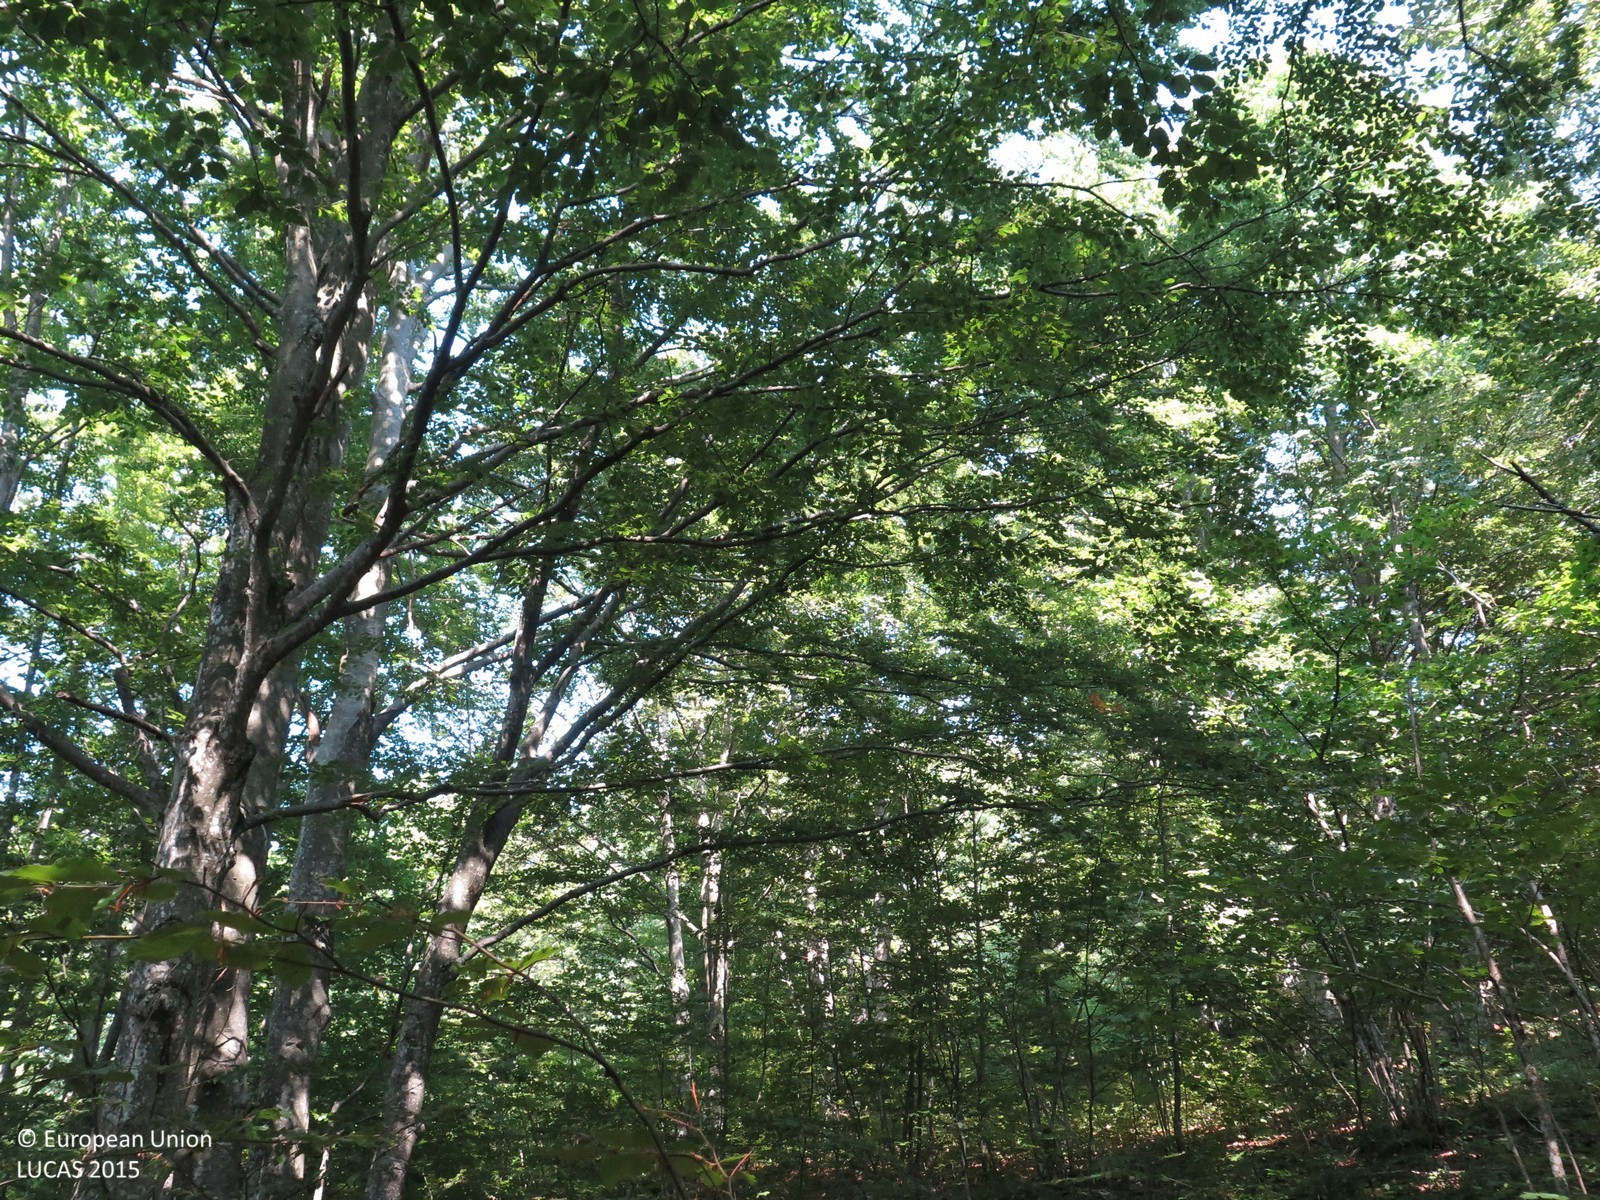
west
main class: Woodland
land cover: Broadleaved woodland
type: beech forest
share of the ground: > 75 %
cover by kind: broadleaved forest trees 95 %, unconsolidated bare surface 5 %
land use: Forestry
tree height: > 5 m
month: August
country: HR
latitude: 45.3745
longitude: 14.8604
